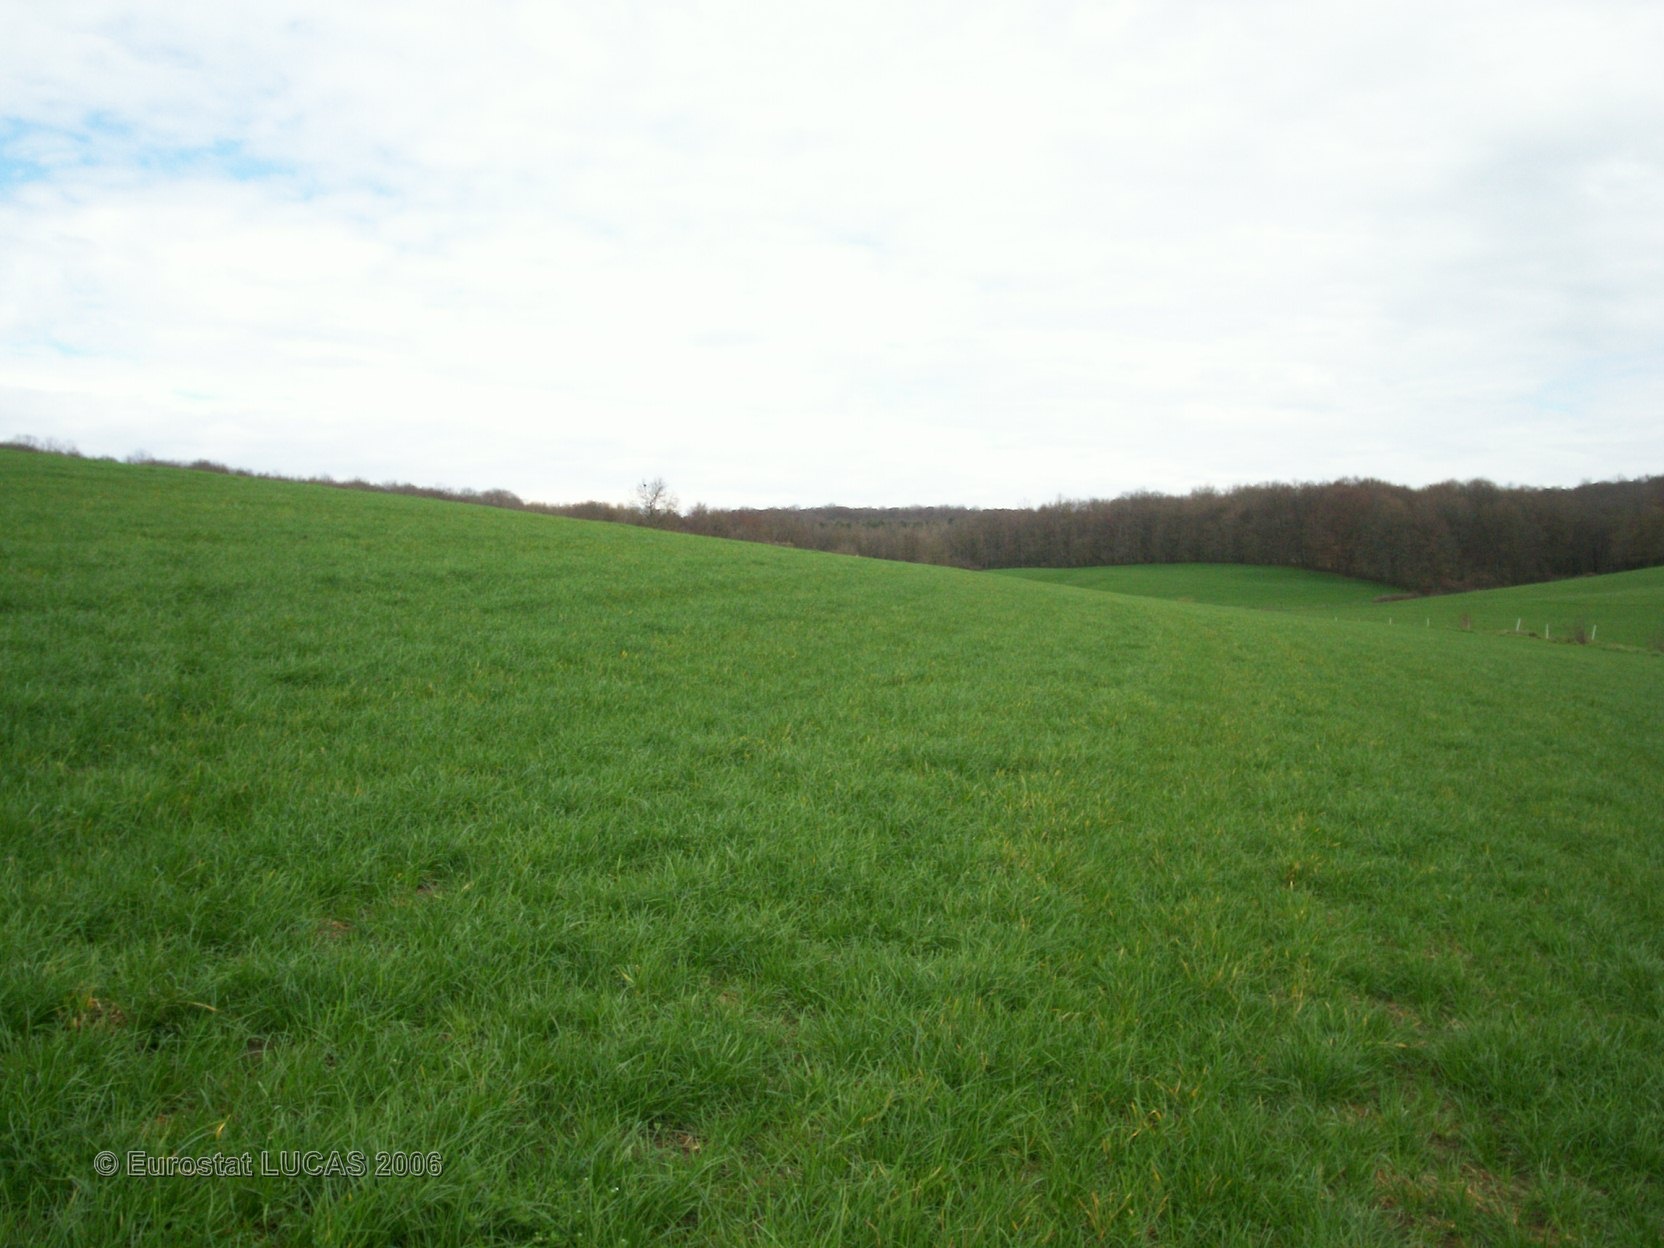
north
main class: Cropland
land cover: Other leguminous and mixtures for fodder
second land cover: Clovers
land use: Agriculture (excluding fallow land and kitchen gardens)
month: April
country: FR
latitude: 48.2571
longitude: 5.9459
